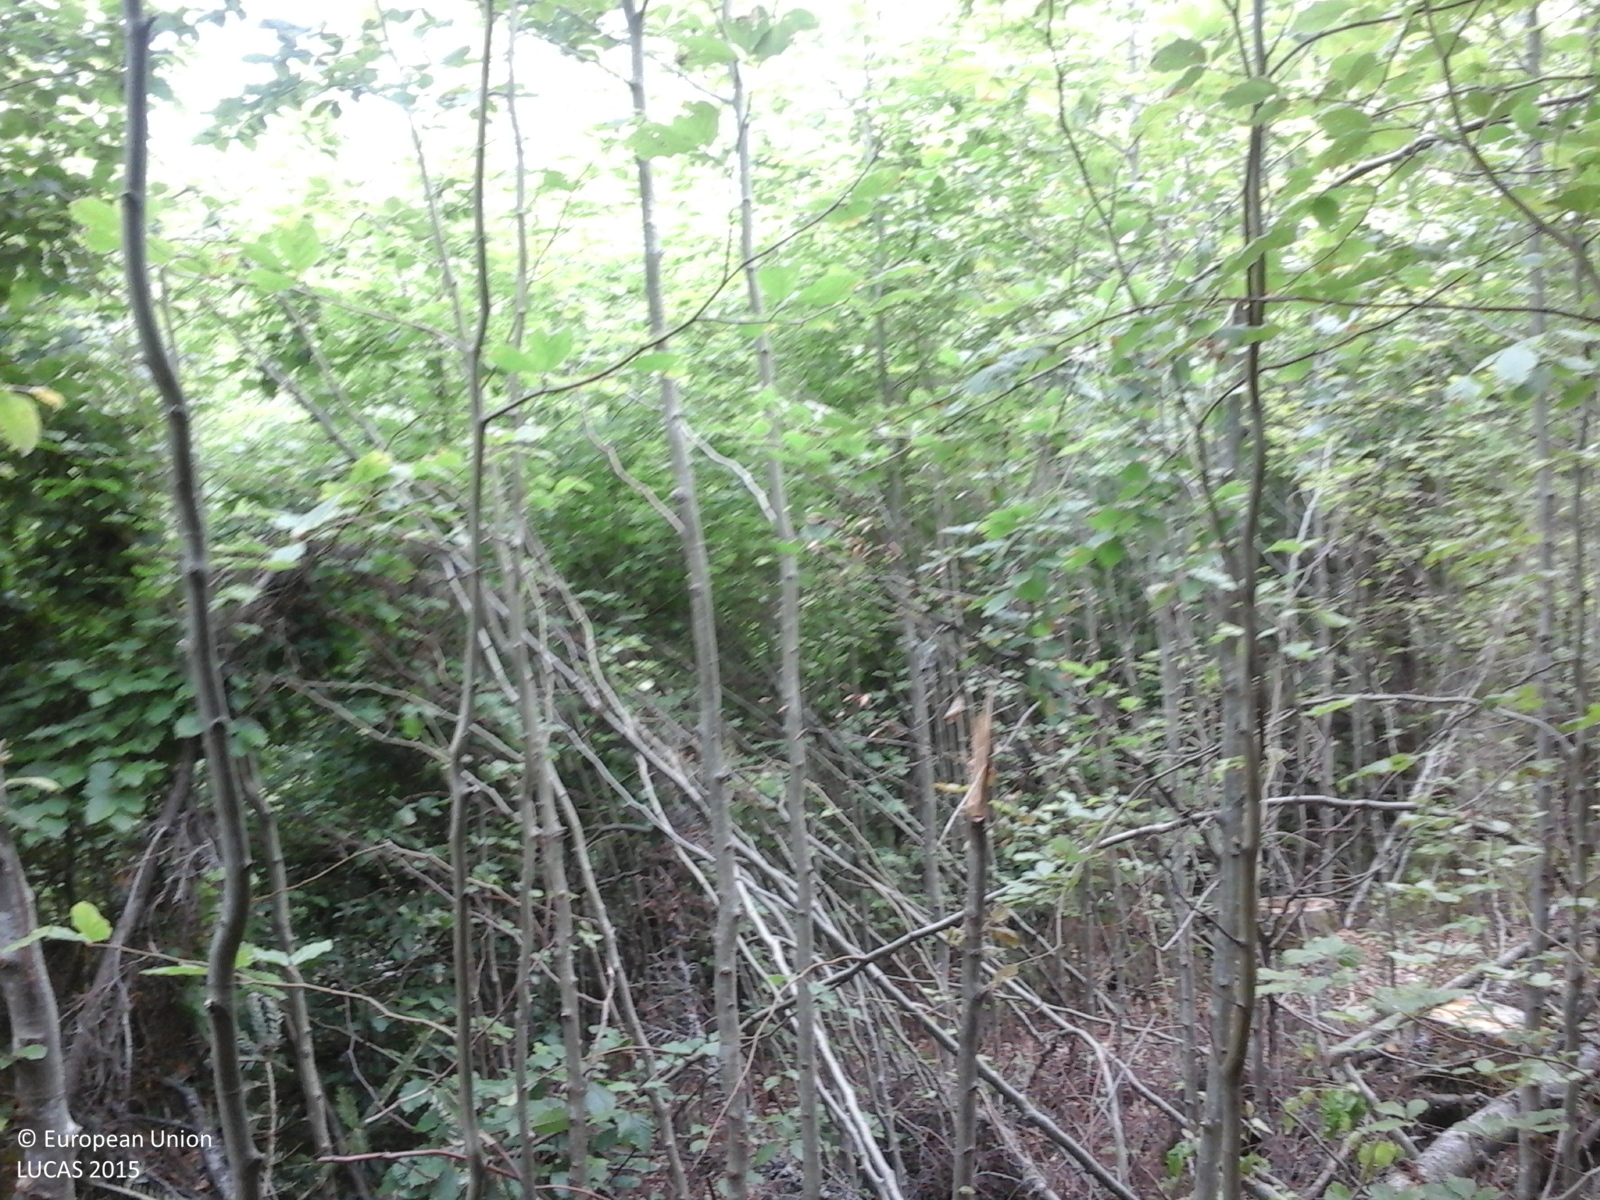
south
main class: Woodland
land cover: Broadleaved woodland
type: beech forest
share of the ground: > 75 %
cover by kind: broadleaved forest trees 100 %
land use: Forestry
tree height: > 5 m
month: June
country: RO
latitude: 47.2912
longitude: 25.0595
